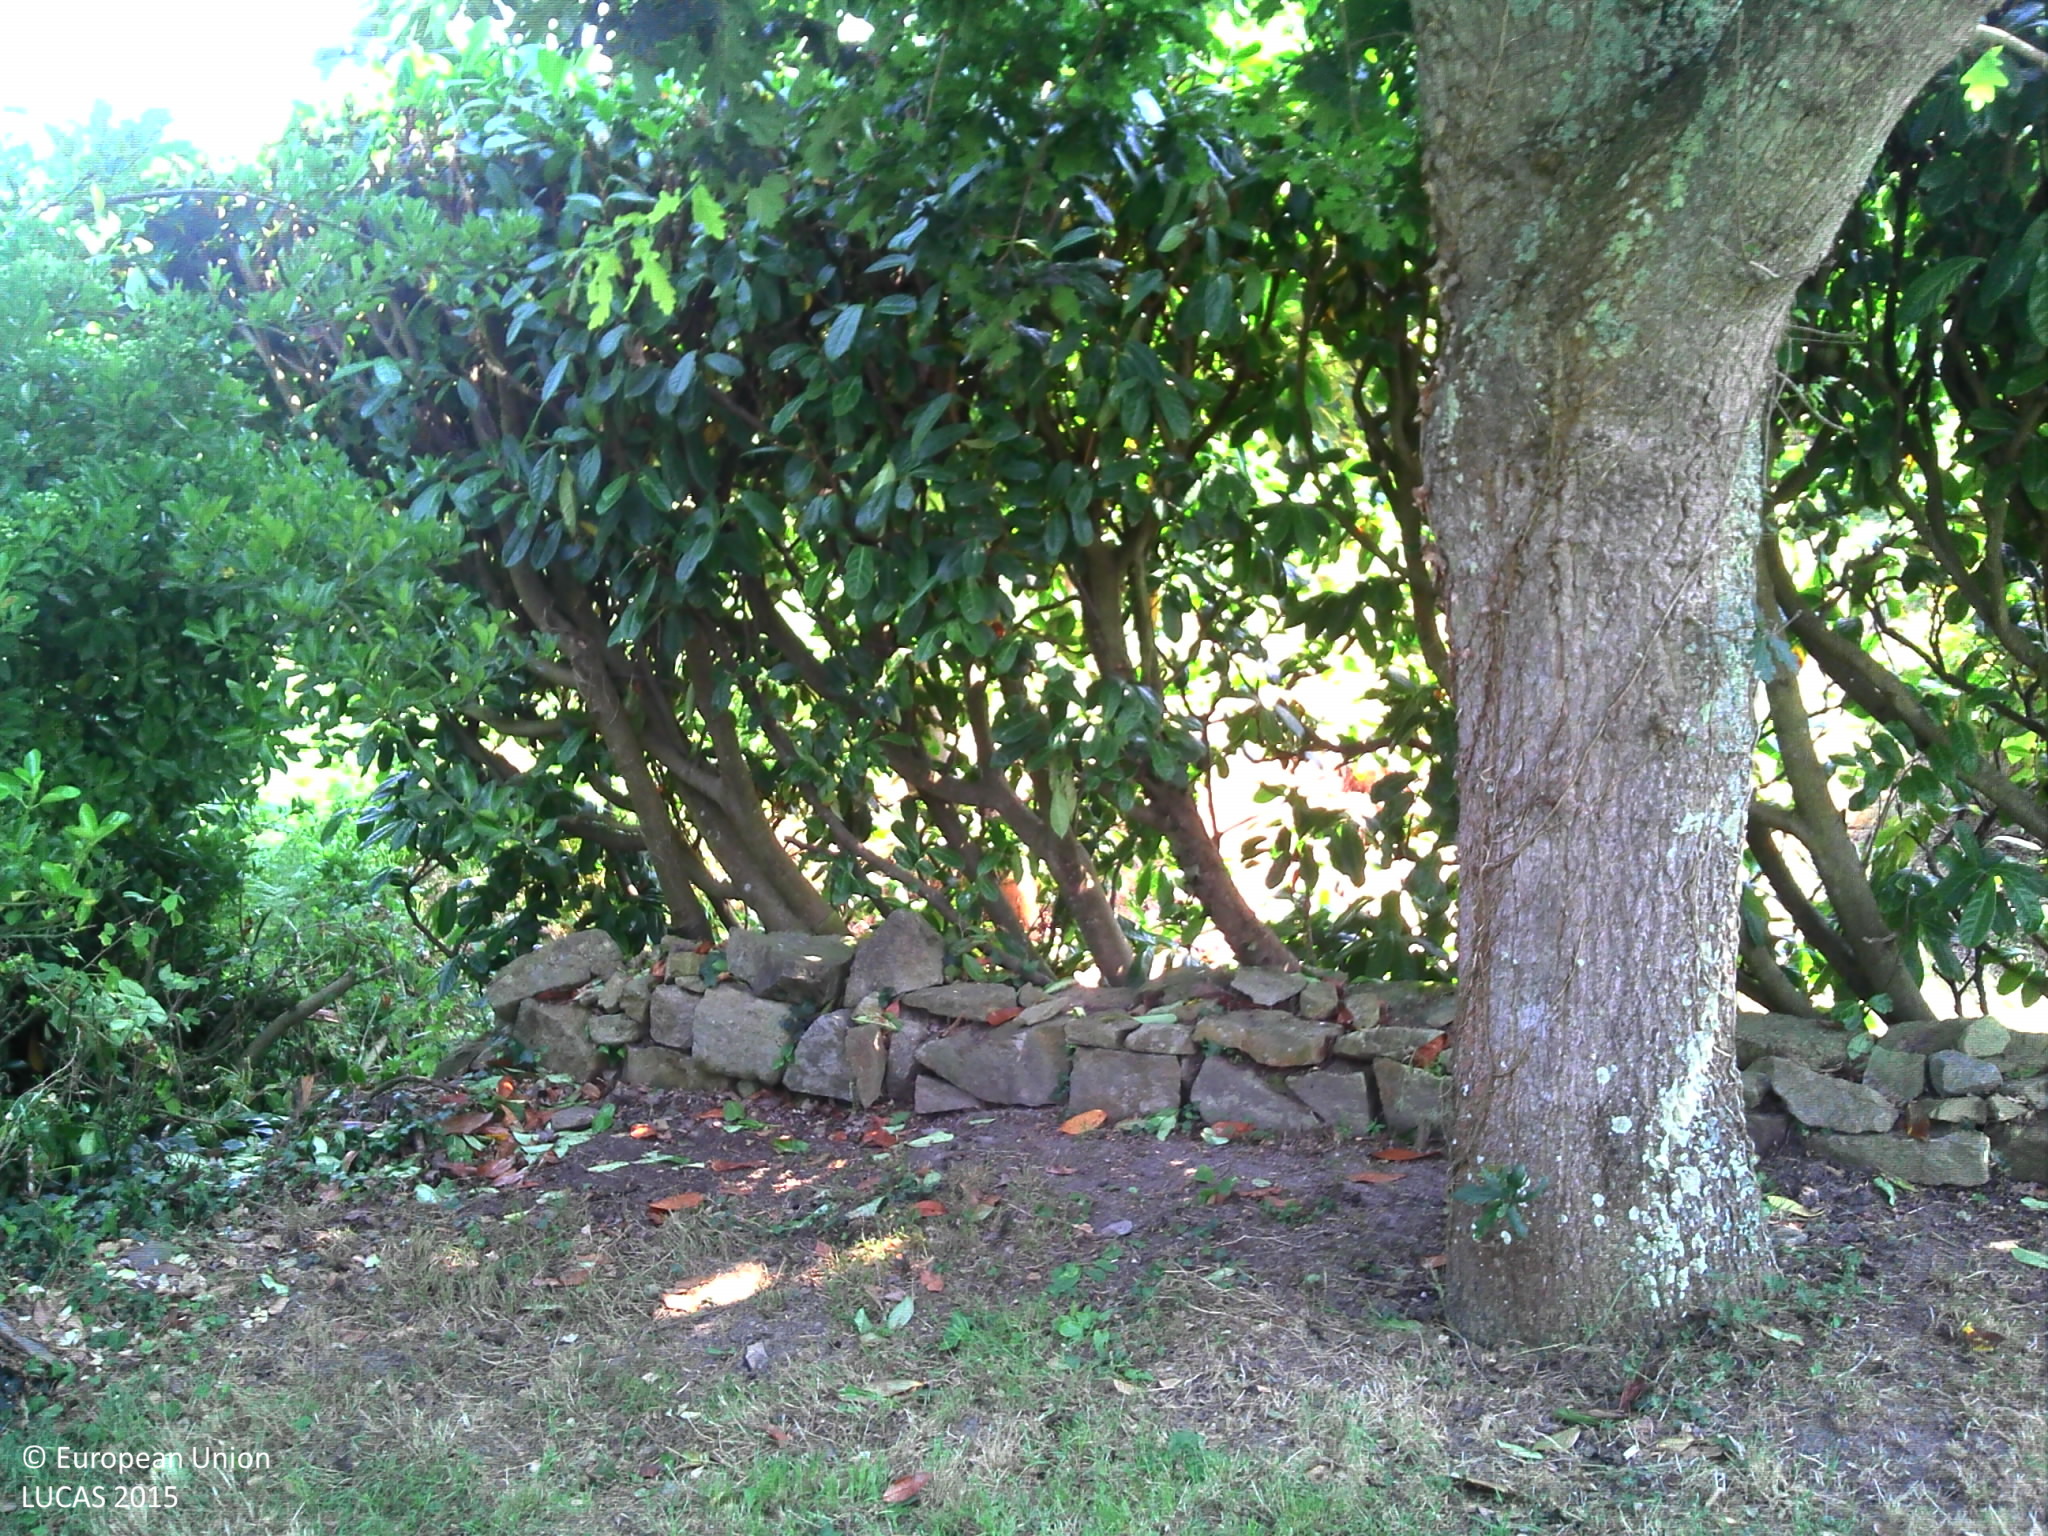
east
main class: Grassland
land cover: Grassland with sparse tree/shrub cover
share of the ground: > 75 %
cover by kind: herbaceous plants 80 %, unconsolidated bare surface 15 %, coniferous forest trees 5 %
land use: Community services
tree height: > 5 m
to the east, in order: Grassland with sparse tree/shrub cover; Electric lines; Broadleaved woodland; Spontaneously vegetated surfaces; Broadleaved woodland
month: July
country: FR
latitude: 48.7845
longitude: -3.5689
